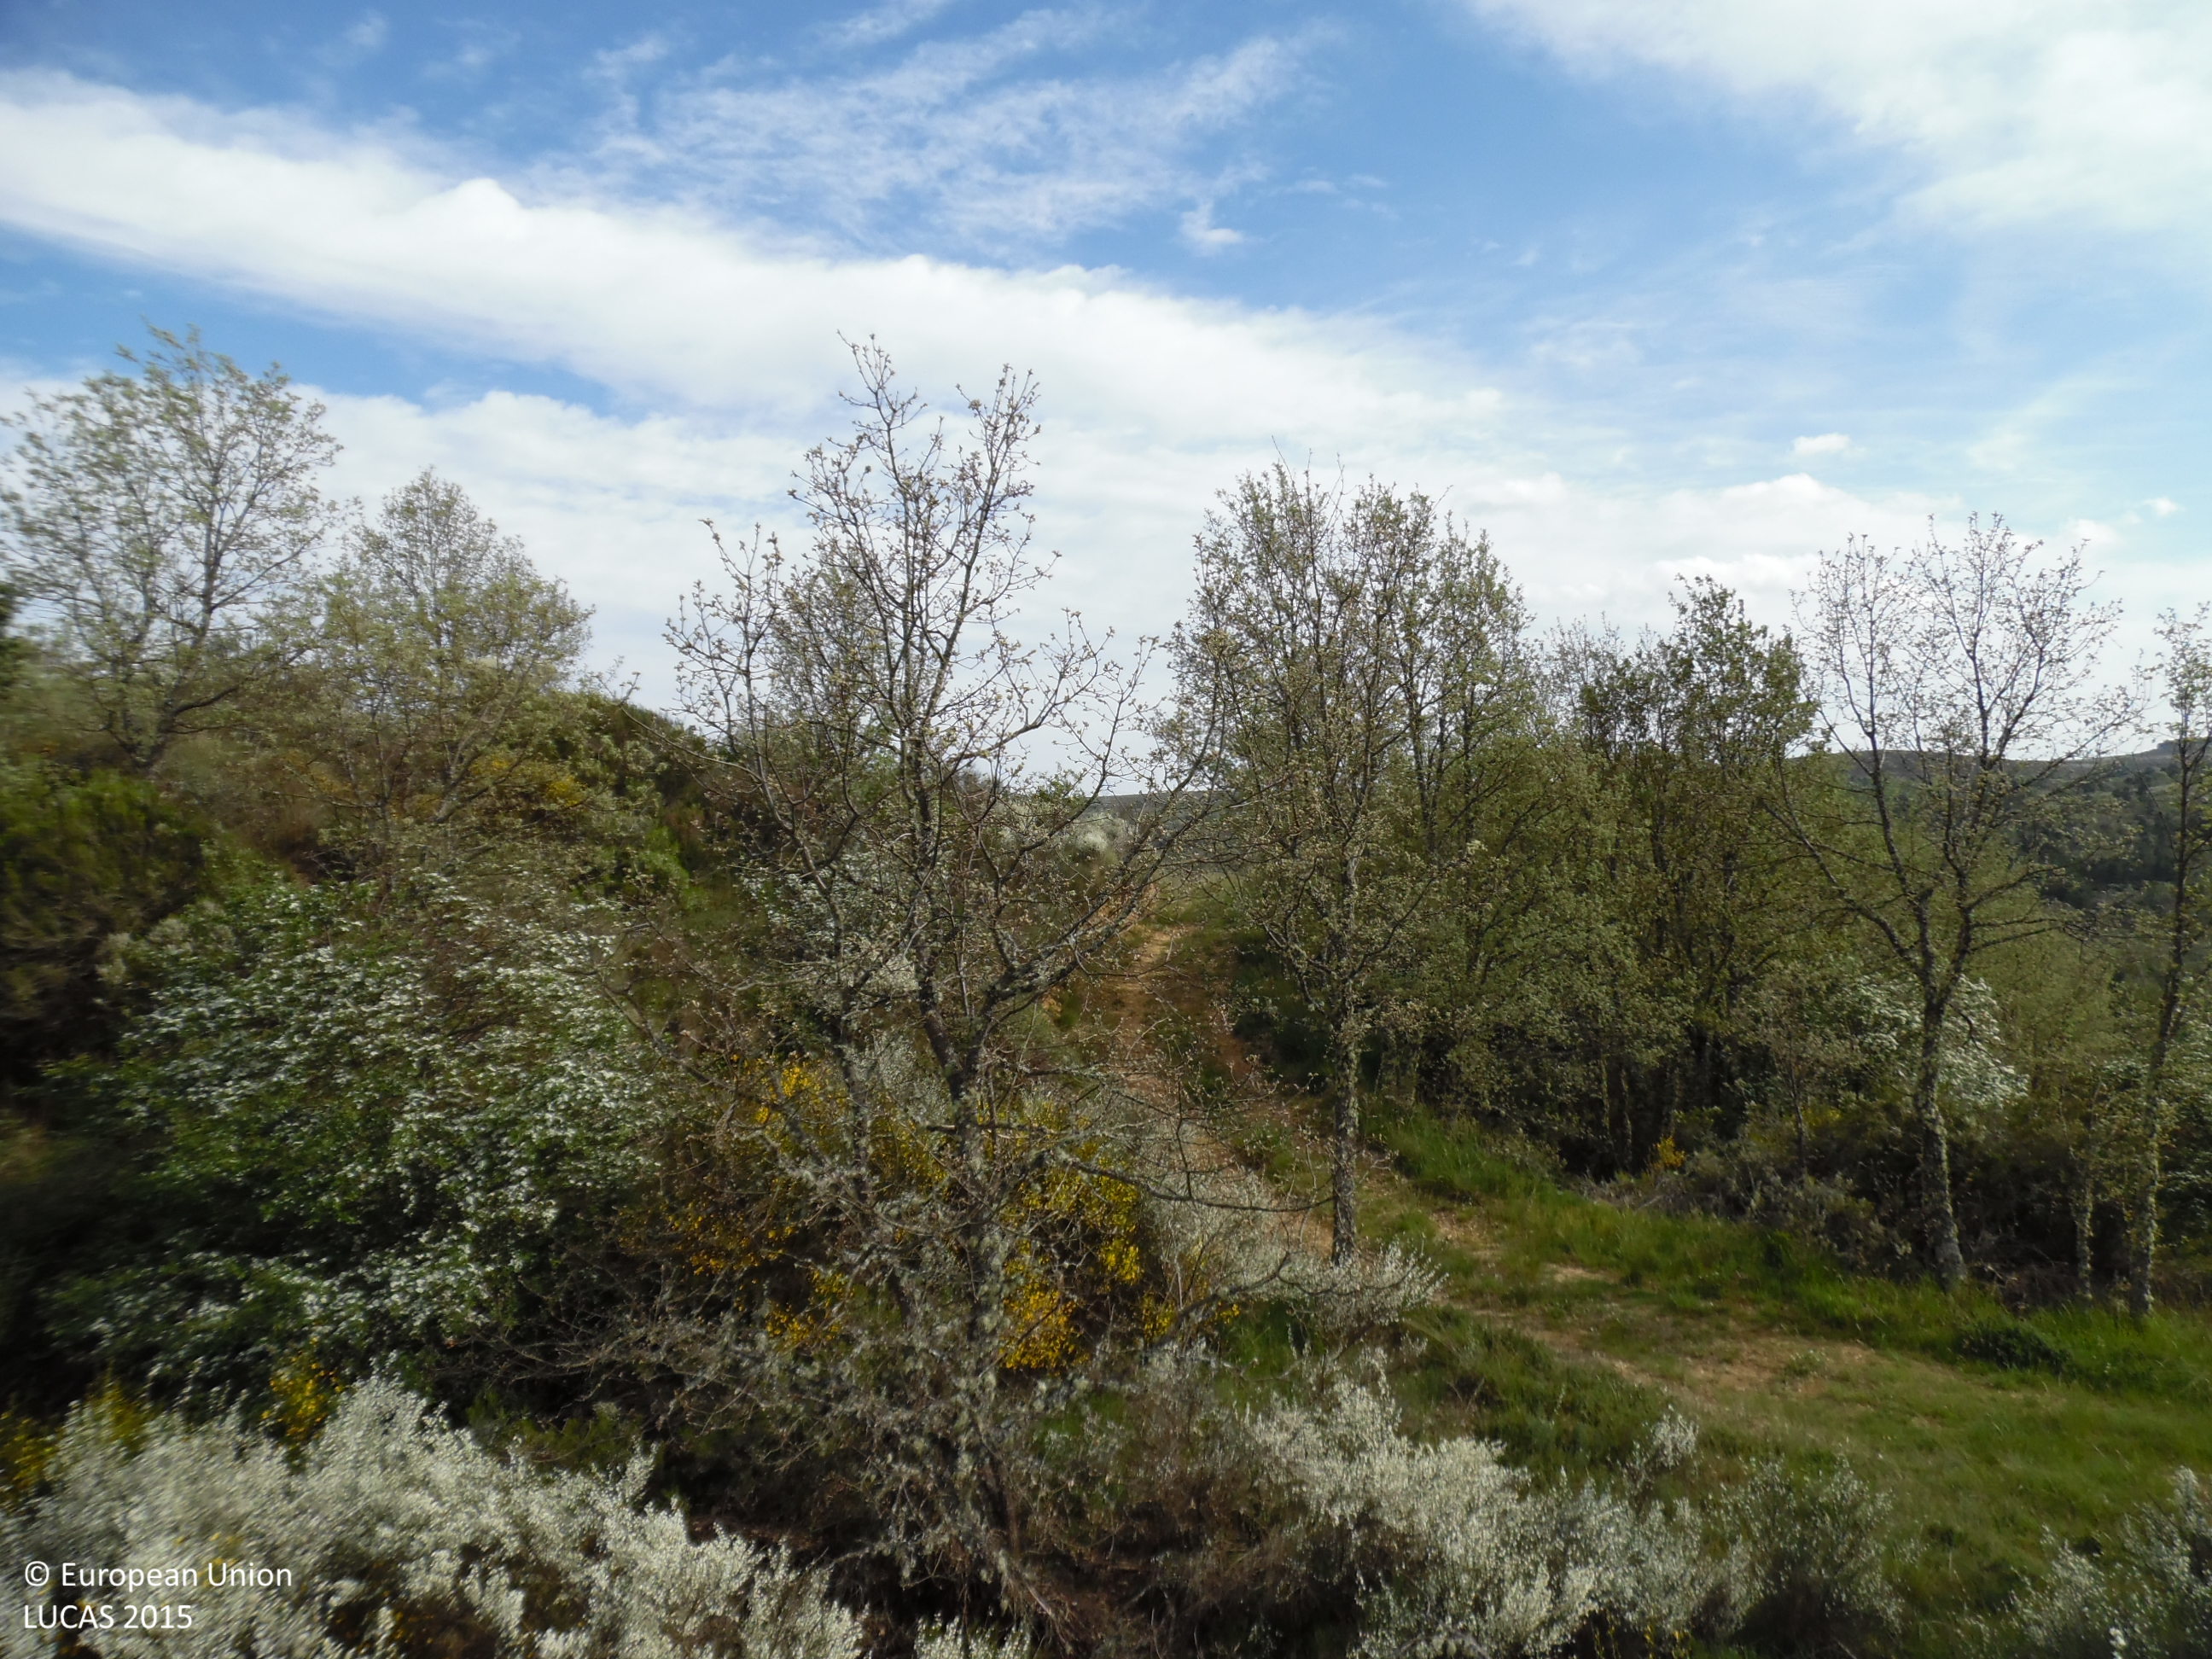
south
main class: Shrubland
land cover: Shrubland without tree cover
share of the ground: > 75 %
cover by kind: shrubs 100 %
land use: Semi-natural and natural areas not in use
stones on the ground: < 10 %
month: May
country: ES
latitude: 42.6037
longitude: -6.1128
